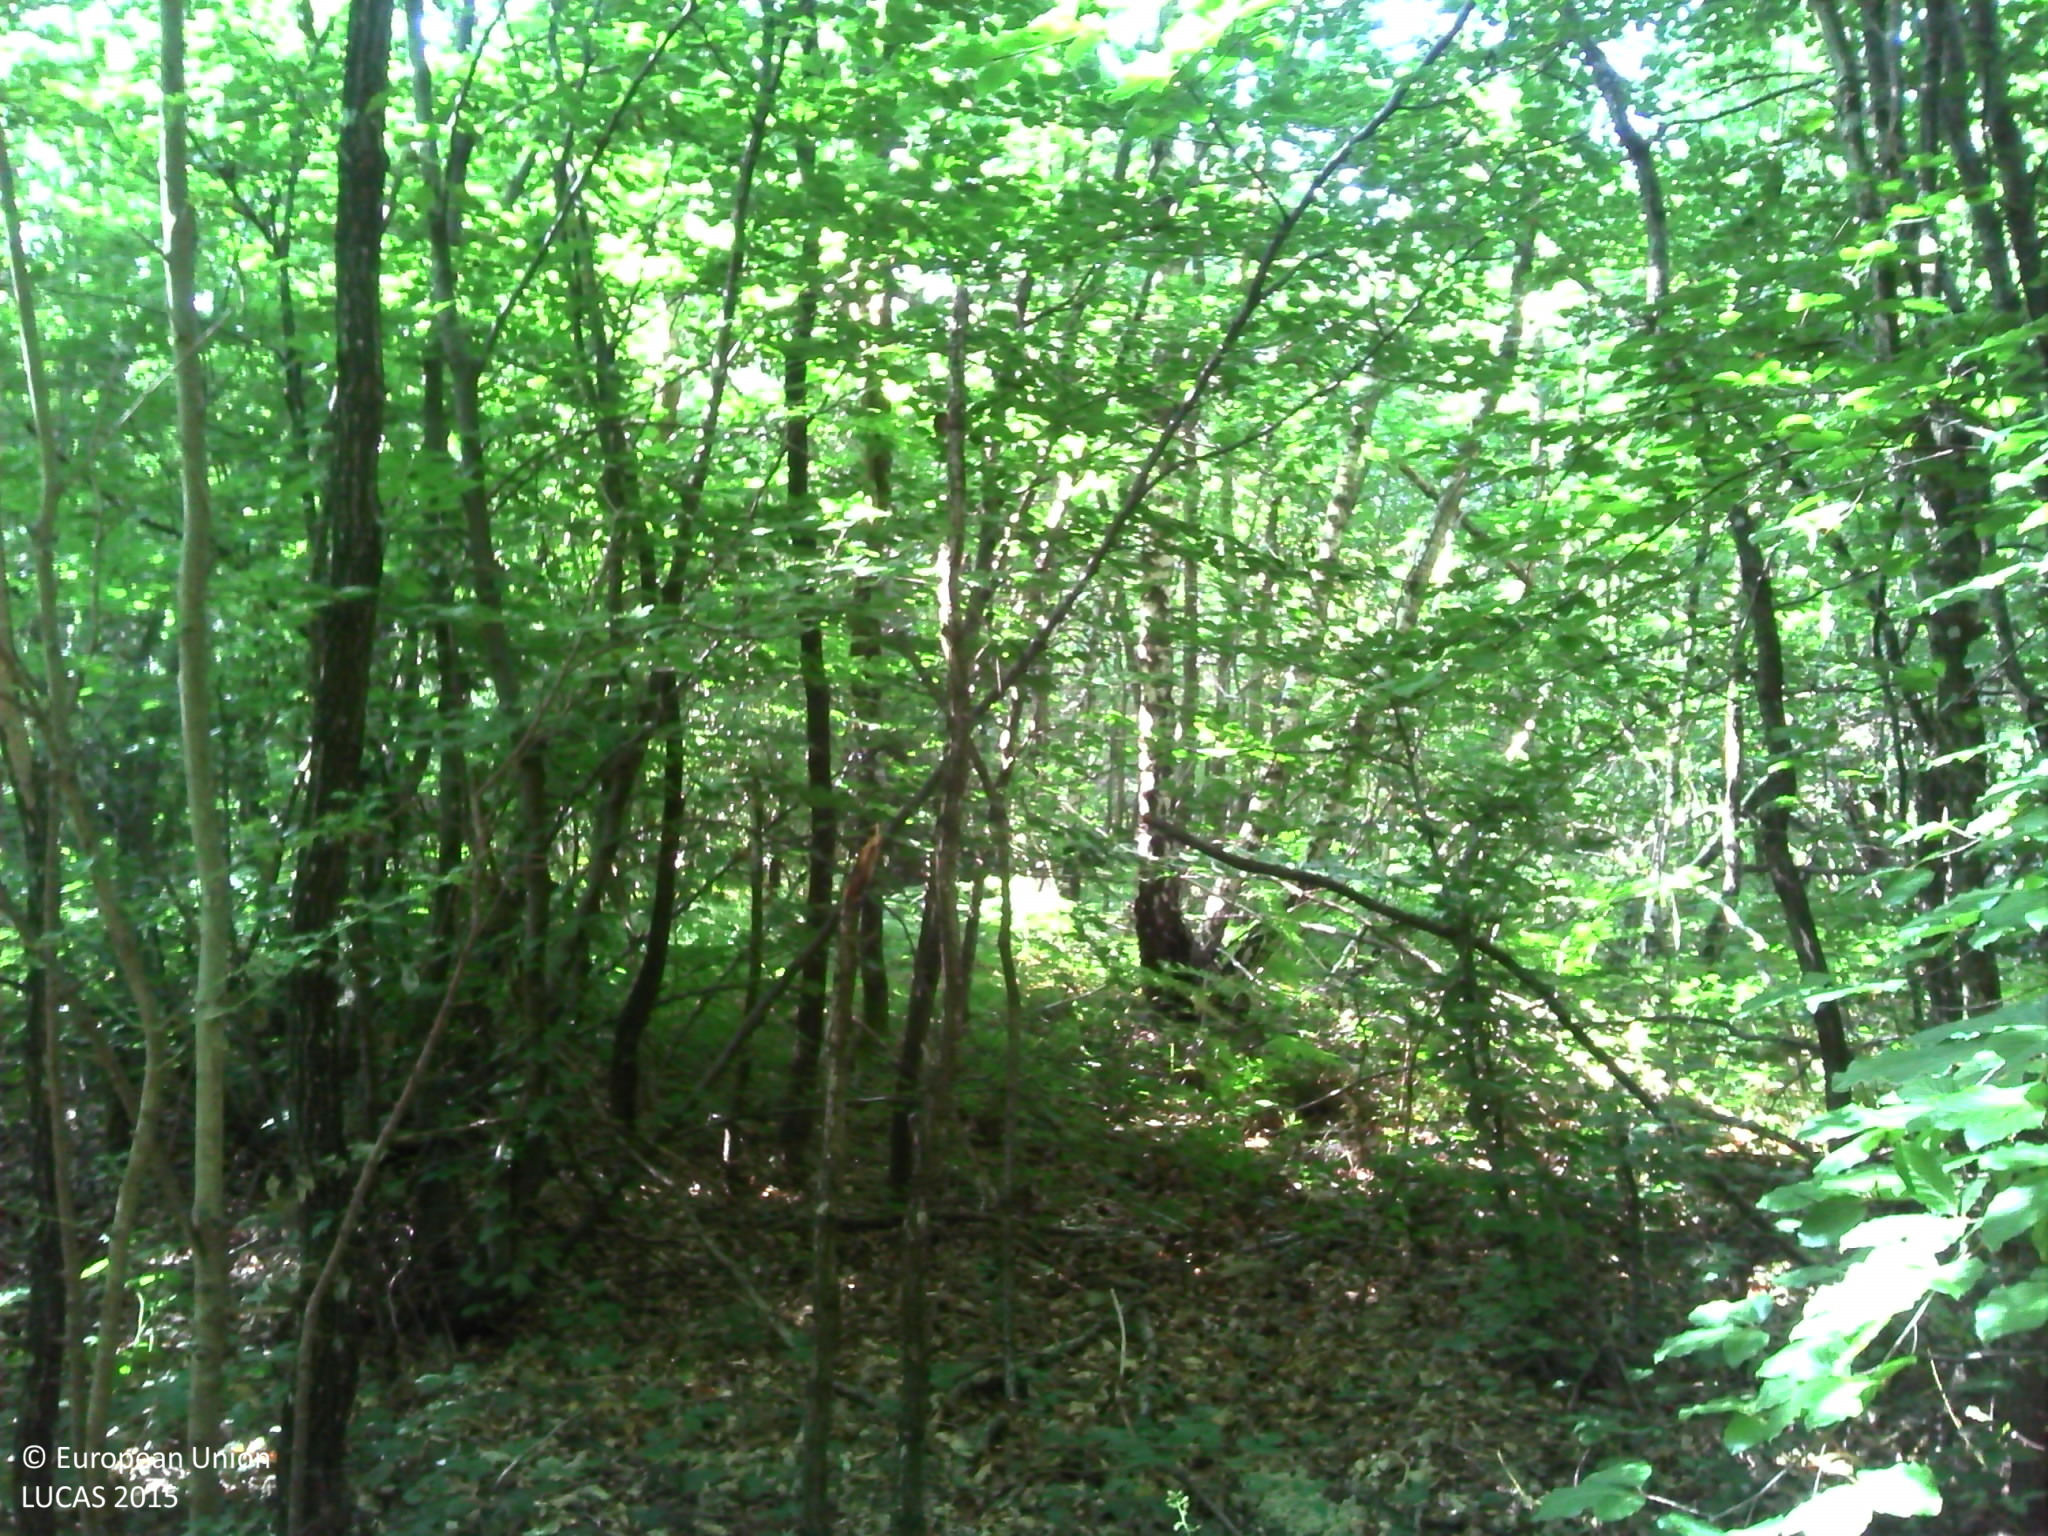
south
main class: Woodland
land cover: Broadleaved woodland
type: beech forest
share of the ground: > 75 %
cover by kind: broadleaved forest trees 90 %, herbaceous plants 5 %, consolidated bare surface 5 %
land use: Forestry
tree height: > 5 m
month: July
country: FR
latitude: 45.4284
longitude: 5.1349
